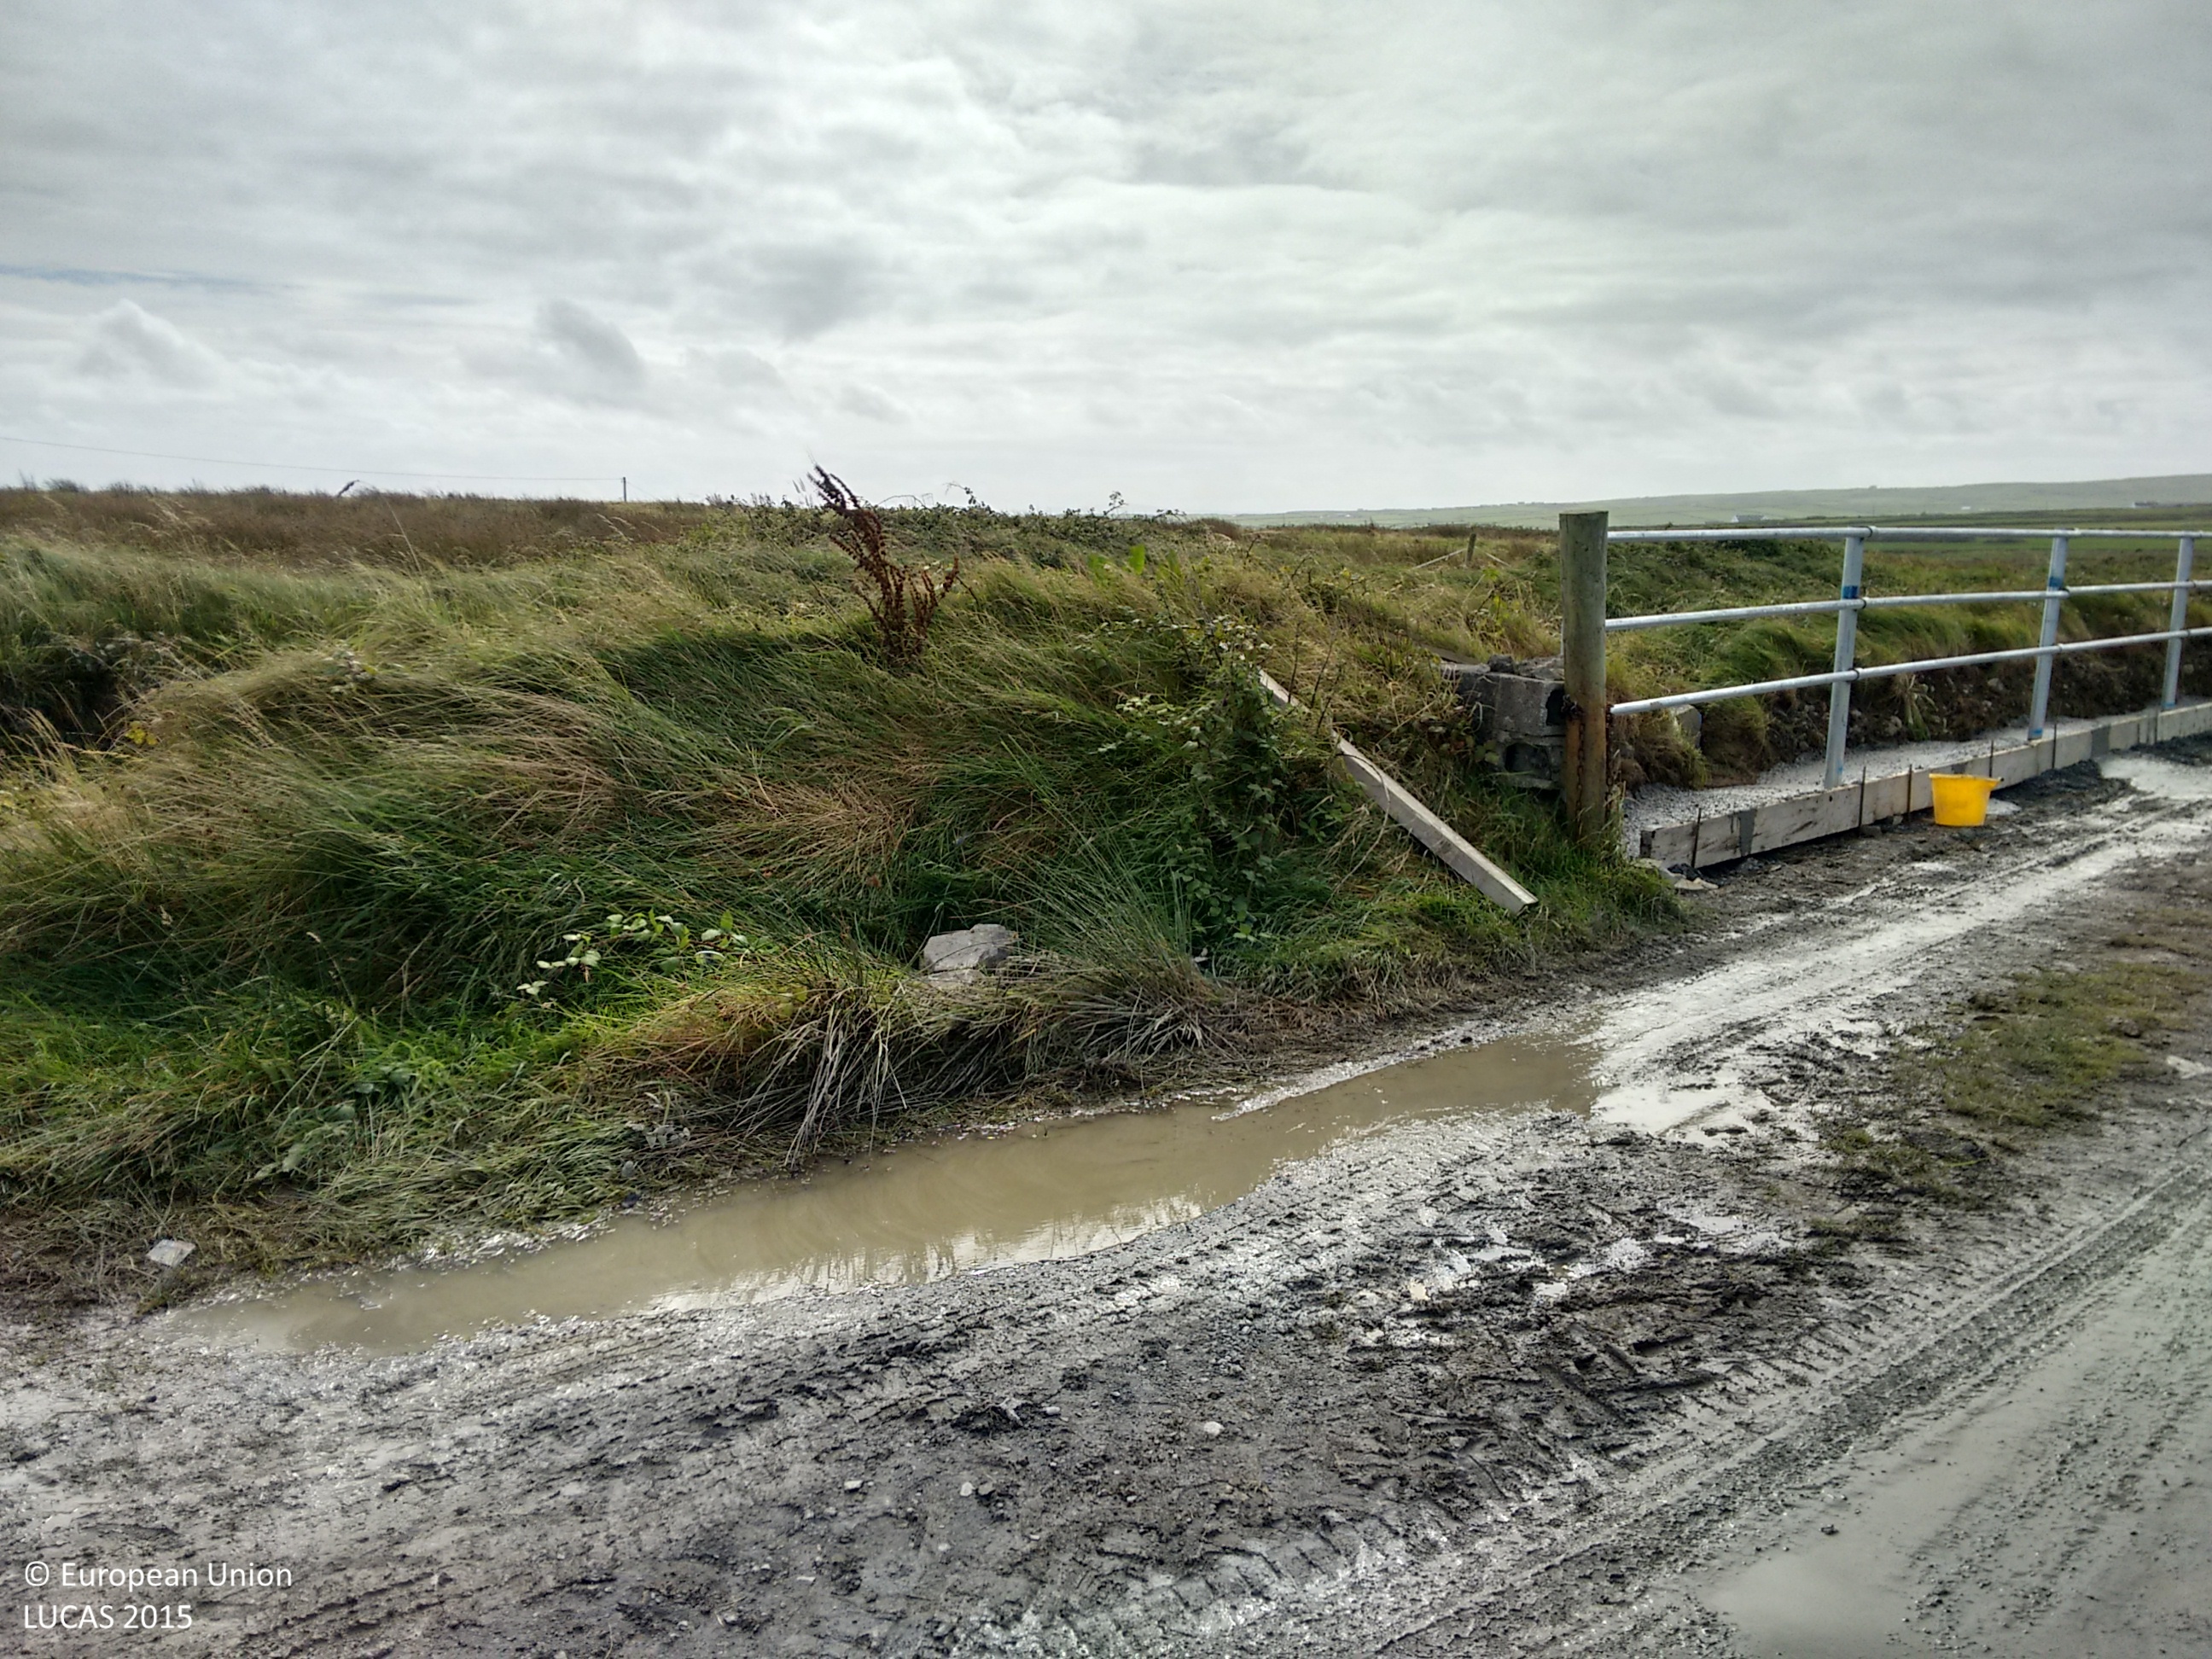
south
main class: Grassland
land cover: Grassland without tree/shrub cover
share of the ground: > 75 %
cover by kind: herbaceous plants 100 %
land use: Agriculture (excluding fallow land and kitchen gardens)
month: September
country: IE
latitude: 52.7406
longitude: -9.5962
